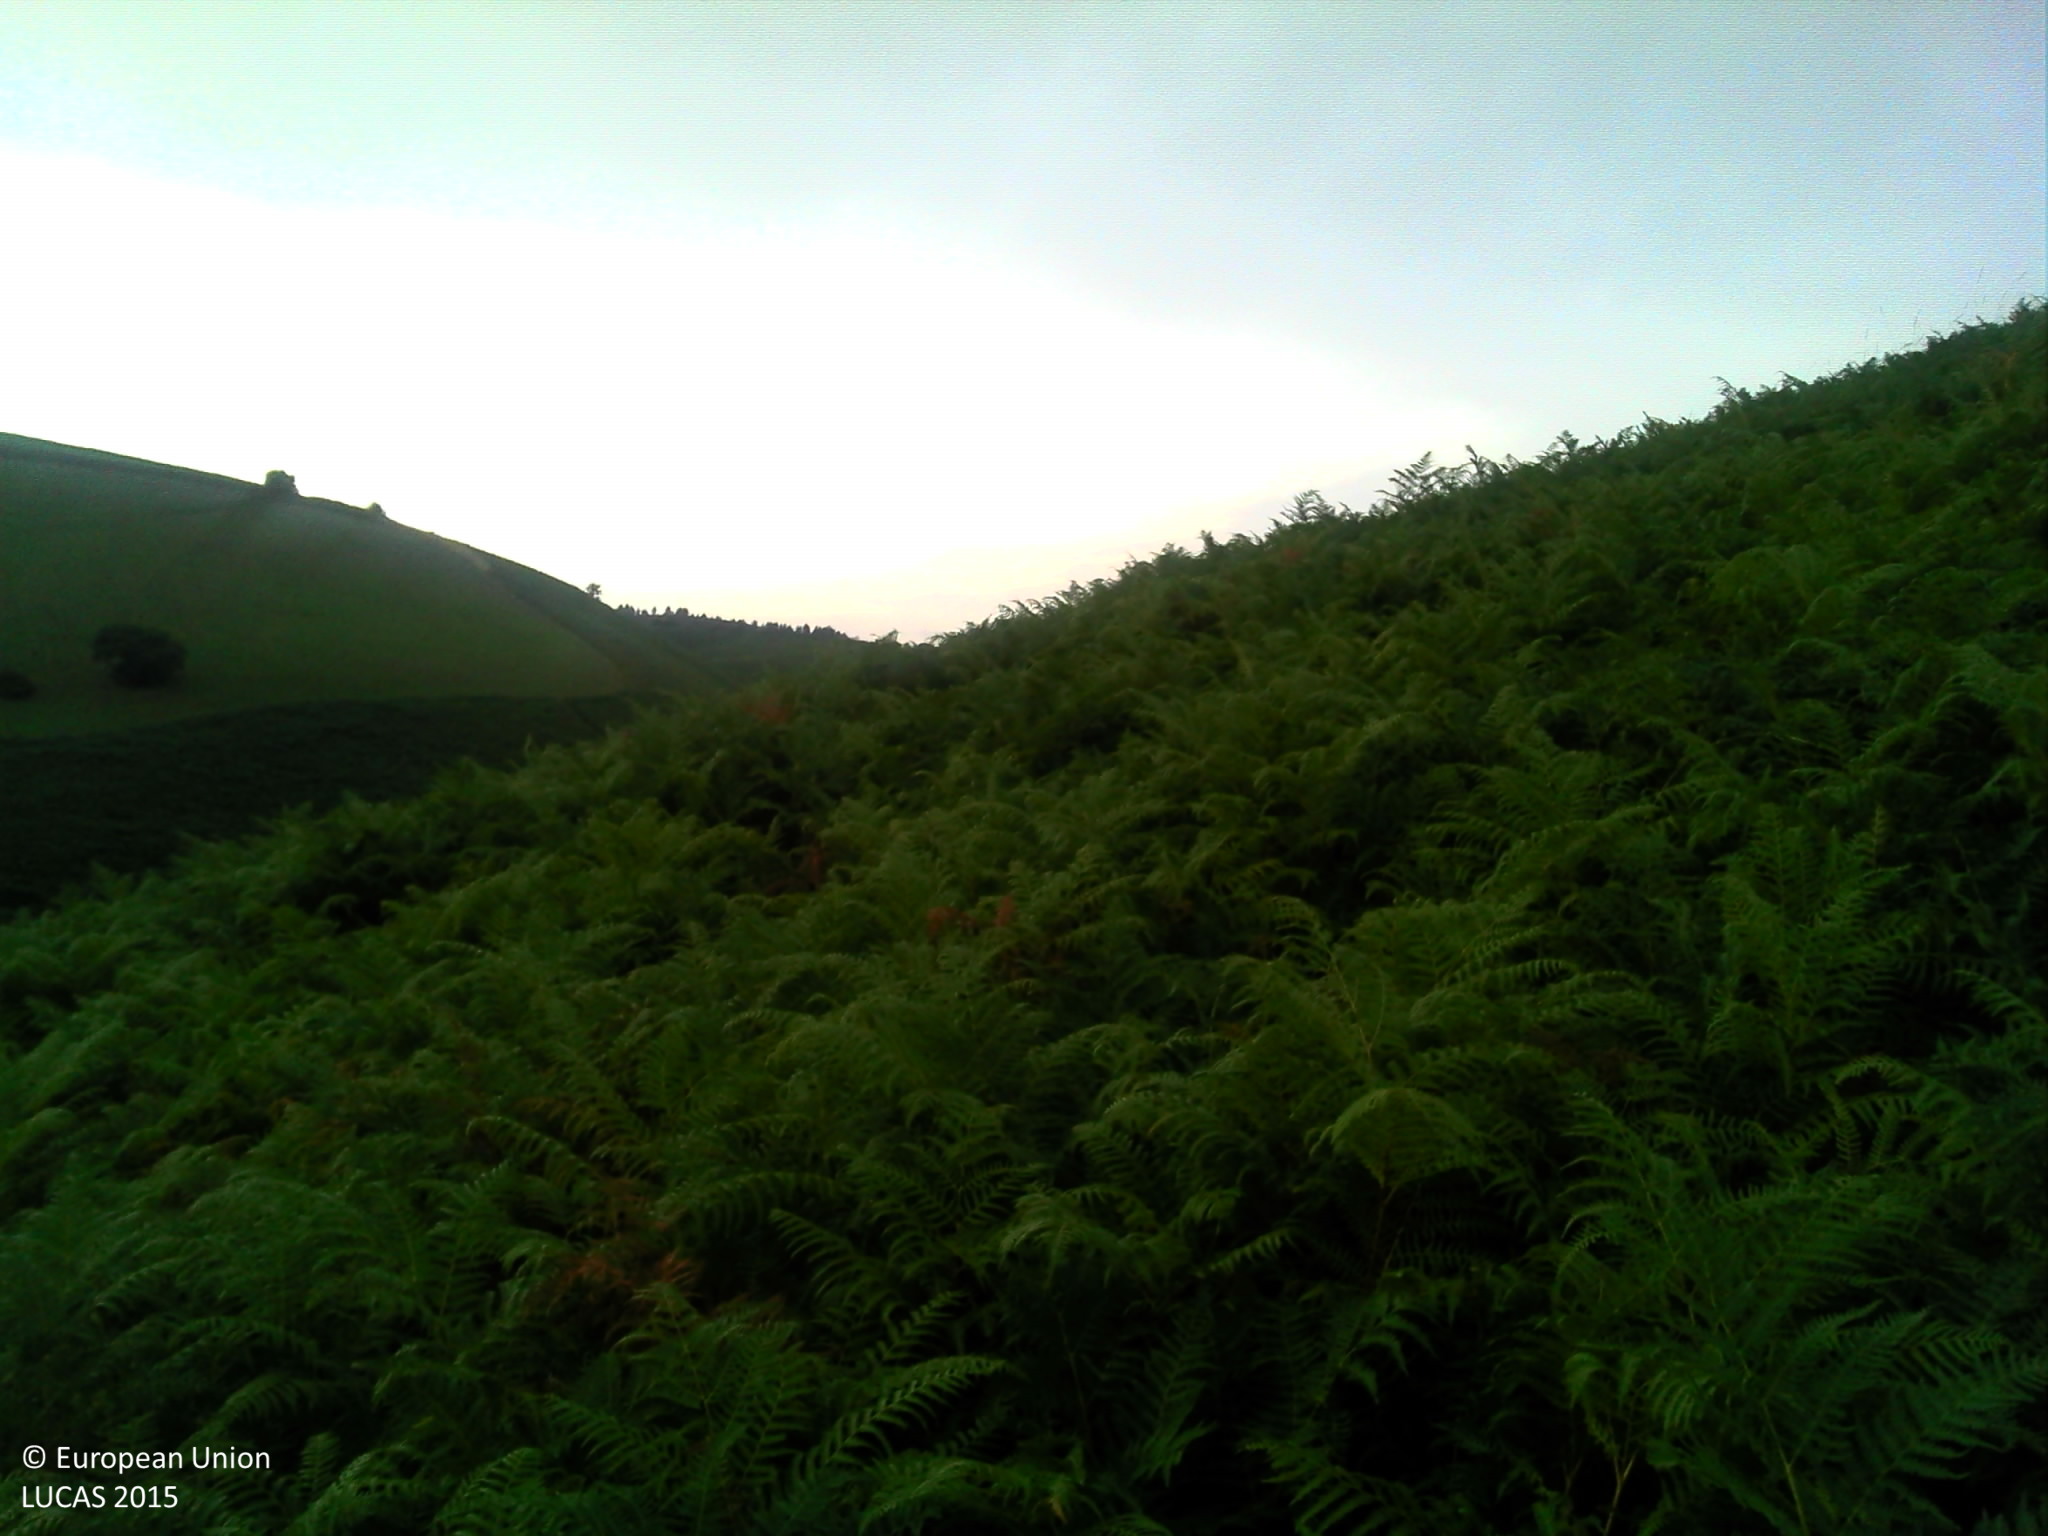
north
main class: Grassland
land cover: Grassland without tree/shrub cover
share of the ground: > 75 %
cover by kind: herbaceous plants 100 %
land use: Agriculture (excluding fallow land and kitchen gardens)
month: August
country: FR
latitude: 43.3799
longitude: -1.1850
